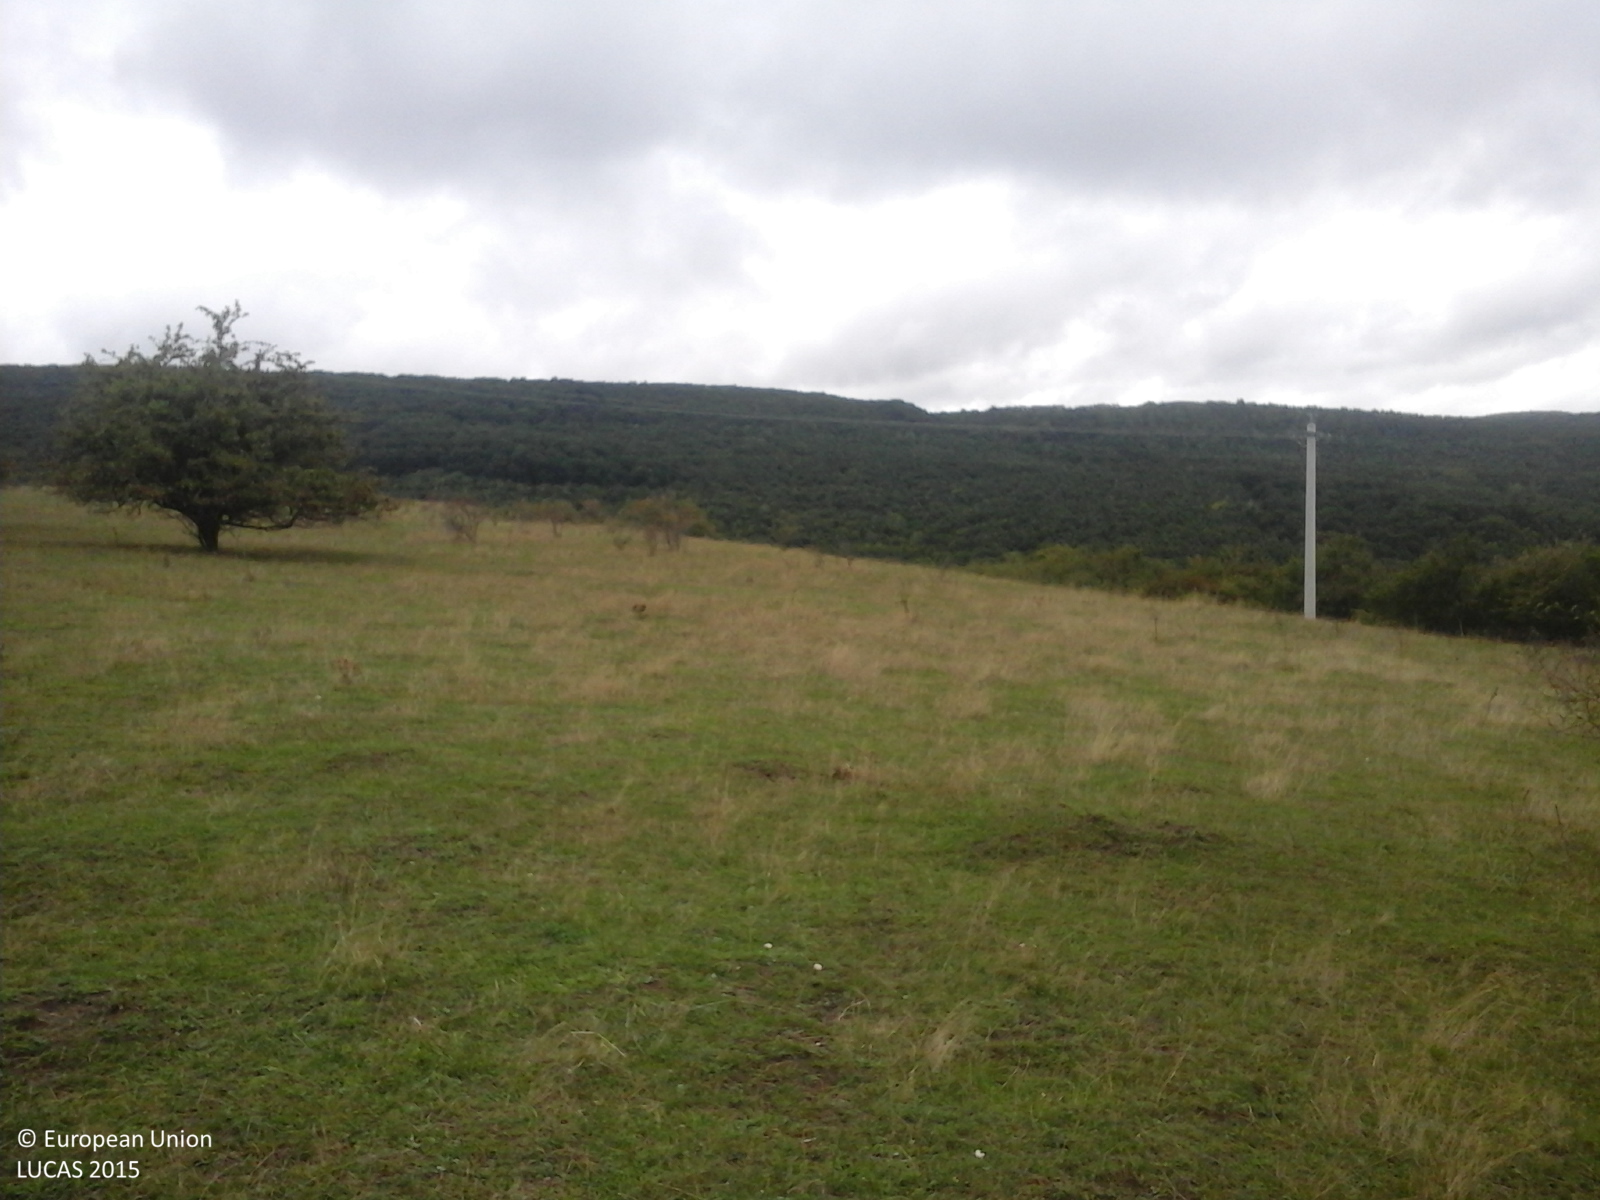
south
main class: Grassland
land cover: Grassland with sparse tree/shrub cover
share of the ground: > 75 %
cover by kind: herbaceous plants 85 %, shrubs 10 %, broadleaved forest trees 5 %
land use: Agriculture (excluding fallow land and kitchen gardens)
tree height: < 5 m
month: September
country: RO
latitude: 45.8443
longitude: 23.7293
